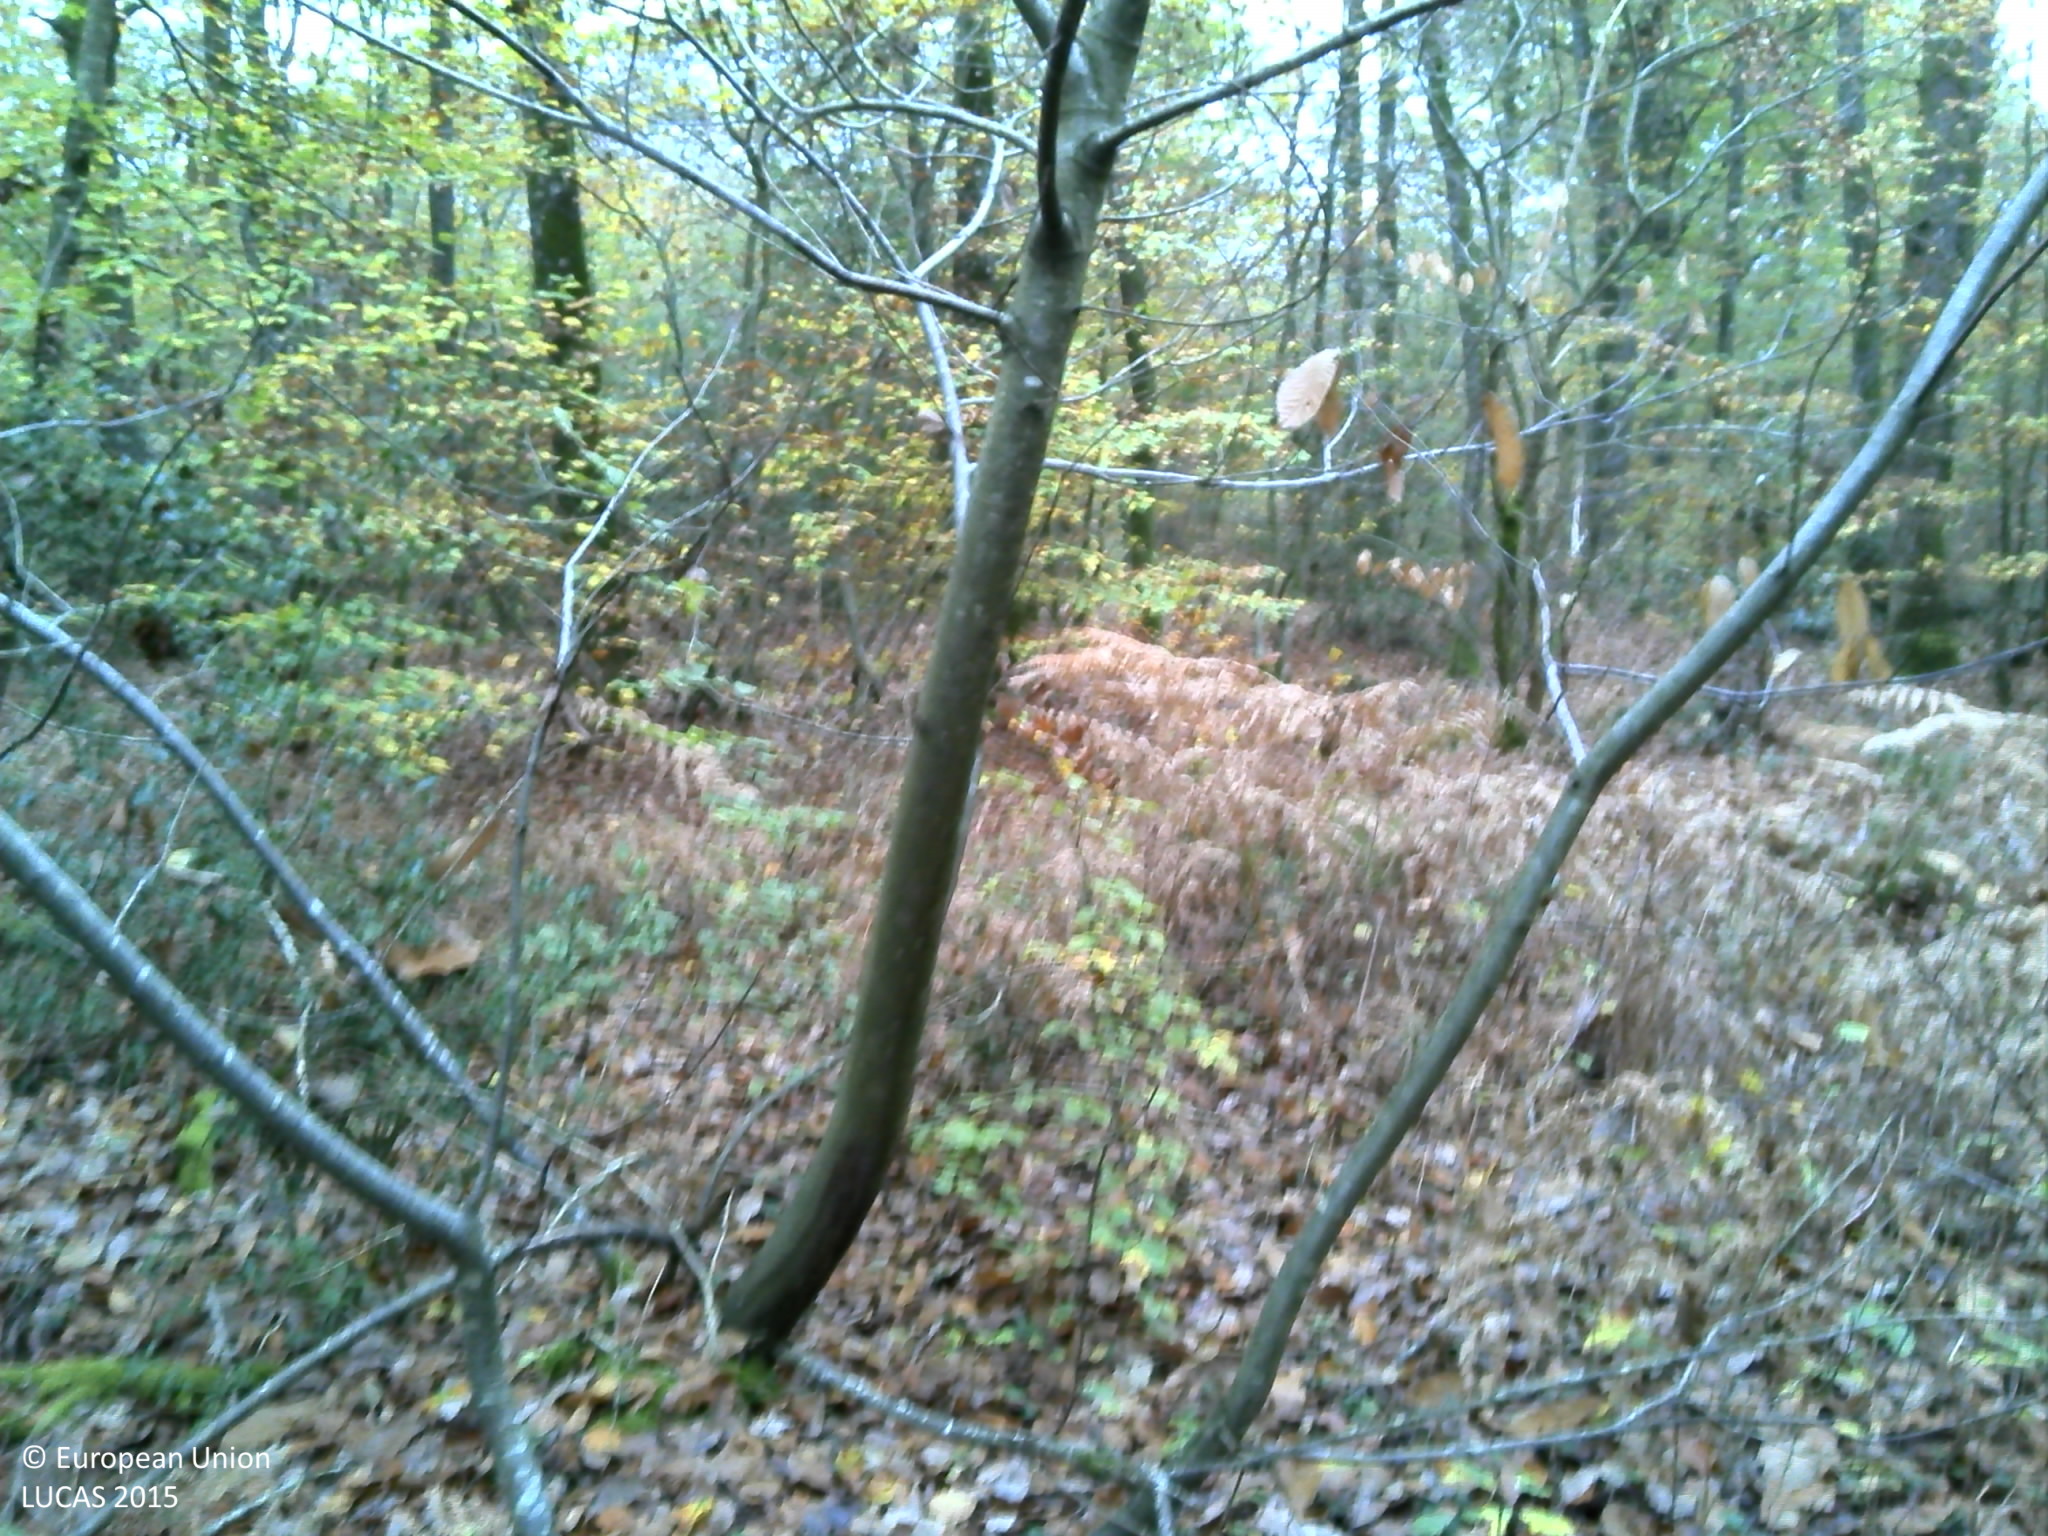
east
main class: Woodland
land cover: Broadleaved woodland
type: acidophilous oak and oak-birch forest
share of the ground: > 75 %
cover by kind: broadleaved forest trees 85 %, herbaceous plants 10 %, lichens and mosses 5 %
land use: Forestry
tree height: > 5 m
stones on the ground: < 10 %
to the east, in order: Broadleaved woodland; Ditches and canals; Tracks; Ditches and canals; Broadleaved woodland
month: November
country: FR
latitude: 47.5474
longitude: -1.3215
